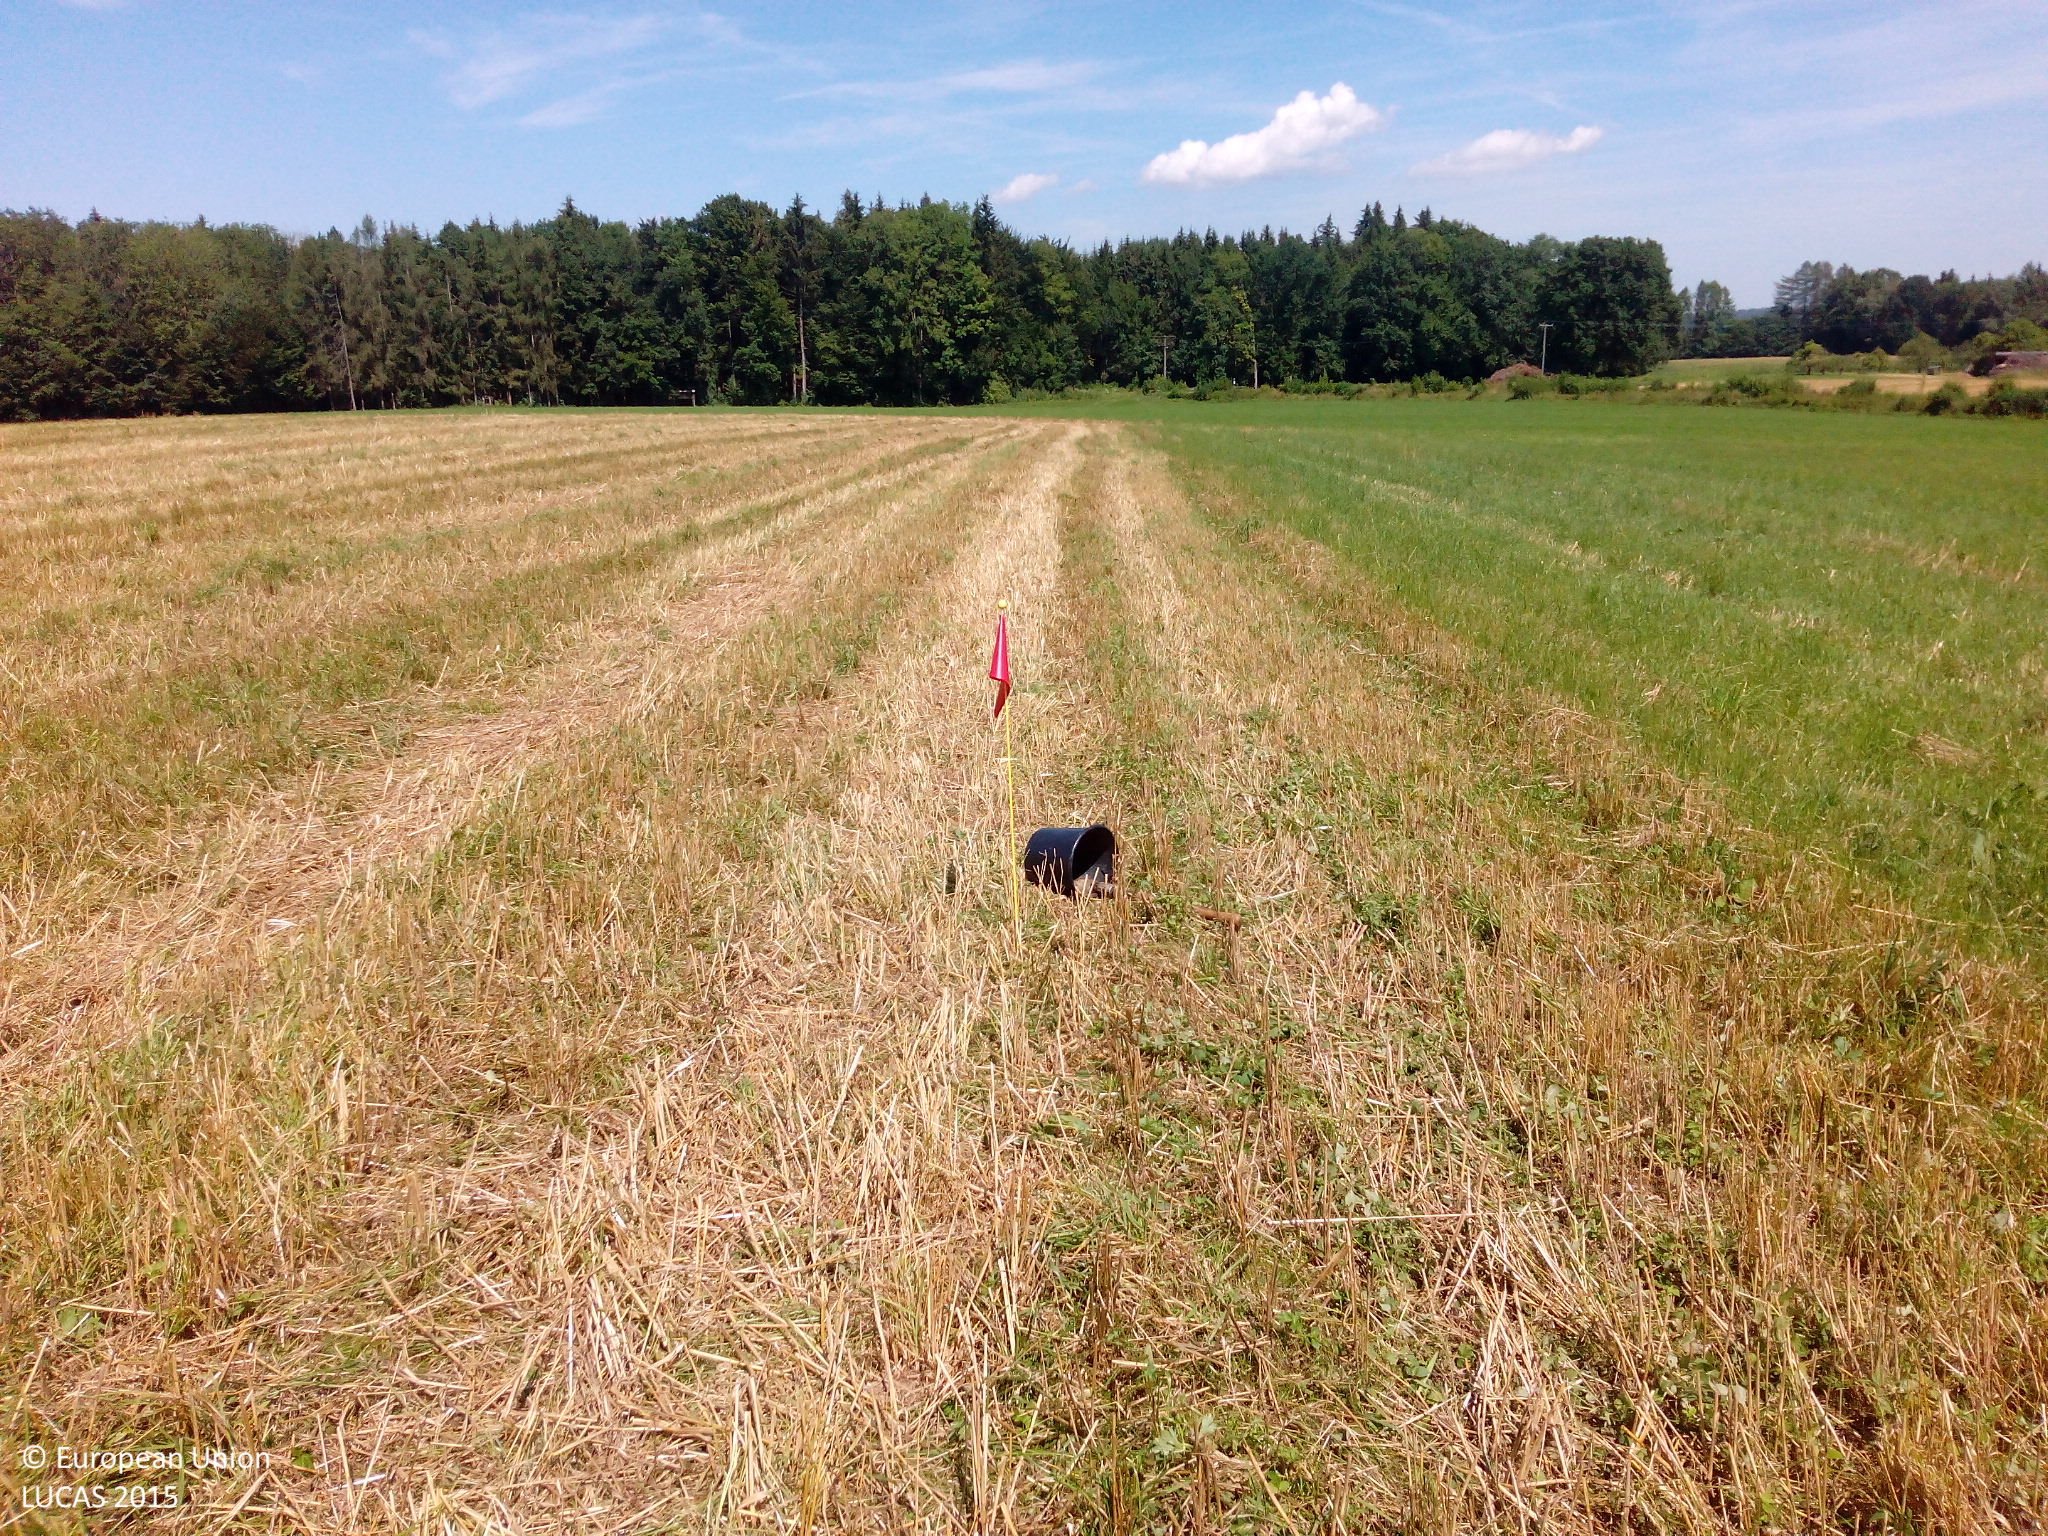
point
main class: Cropland
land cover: Common wheat
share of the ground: > 75 %
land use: Agriculture (excluding fallow land and kitchen gardens)
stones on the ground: < 10 %
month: August
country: DE
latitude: 47.9519
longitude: 12.8776
